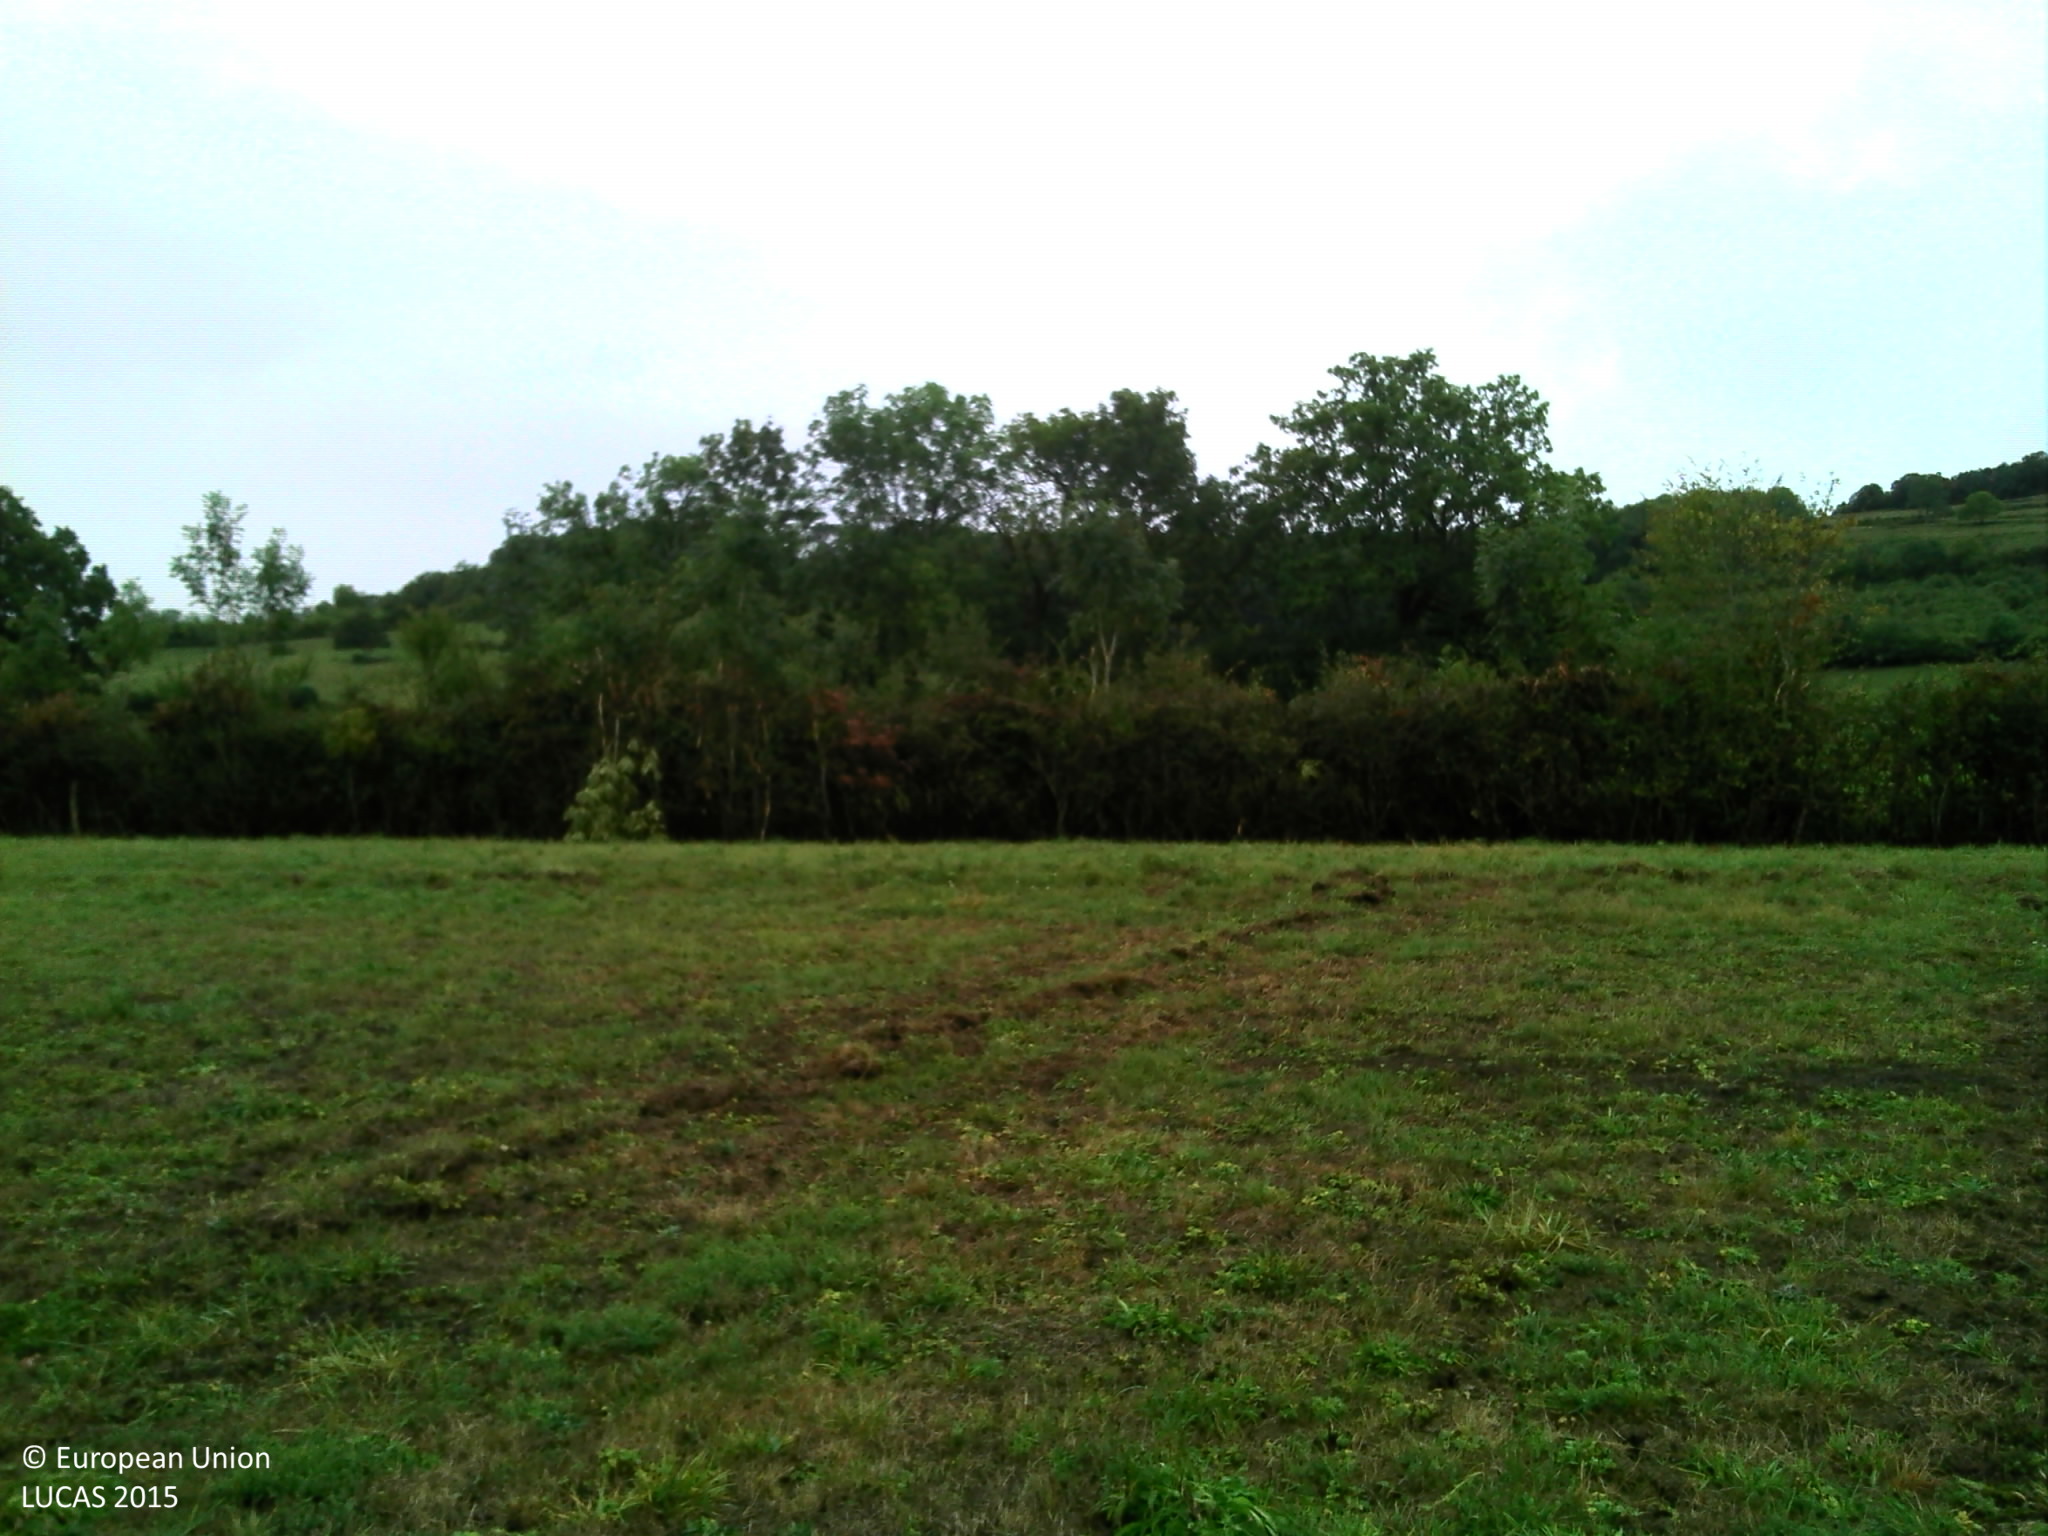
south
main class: Grassland
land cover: Grassland without tree/shrub cover
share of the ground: > 75 %
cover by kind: herbaceous plants 100 %
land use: Agriculture (excluding fallow land and kitchen gardens)
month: September
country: FR
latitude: 47.3582
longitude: 4.3722
